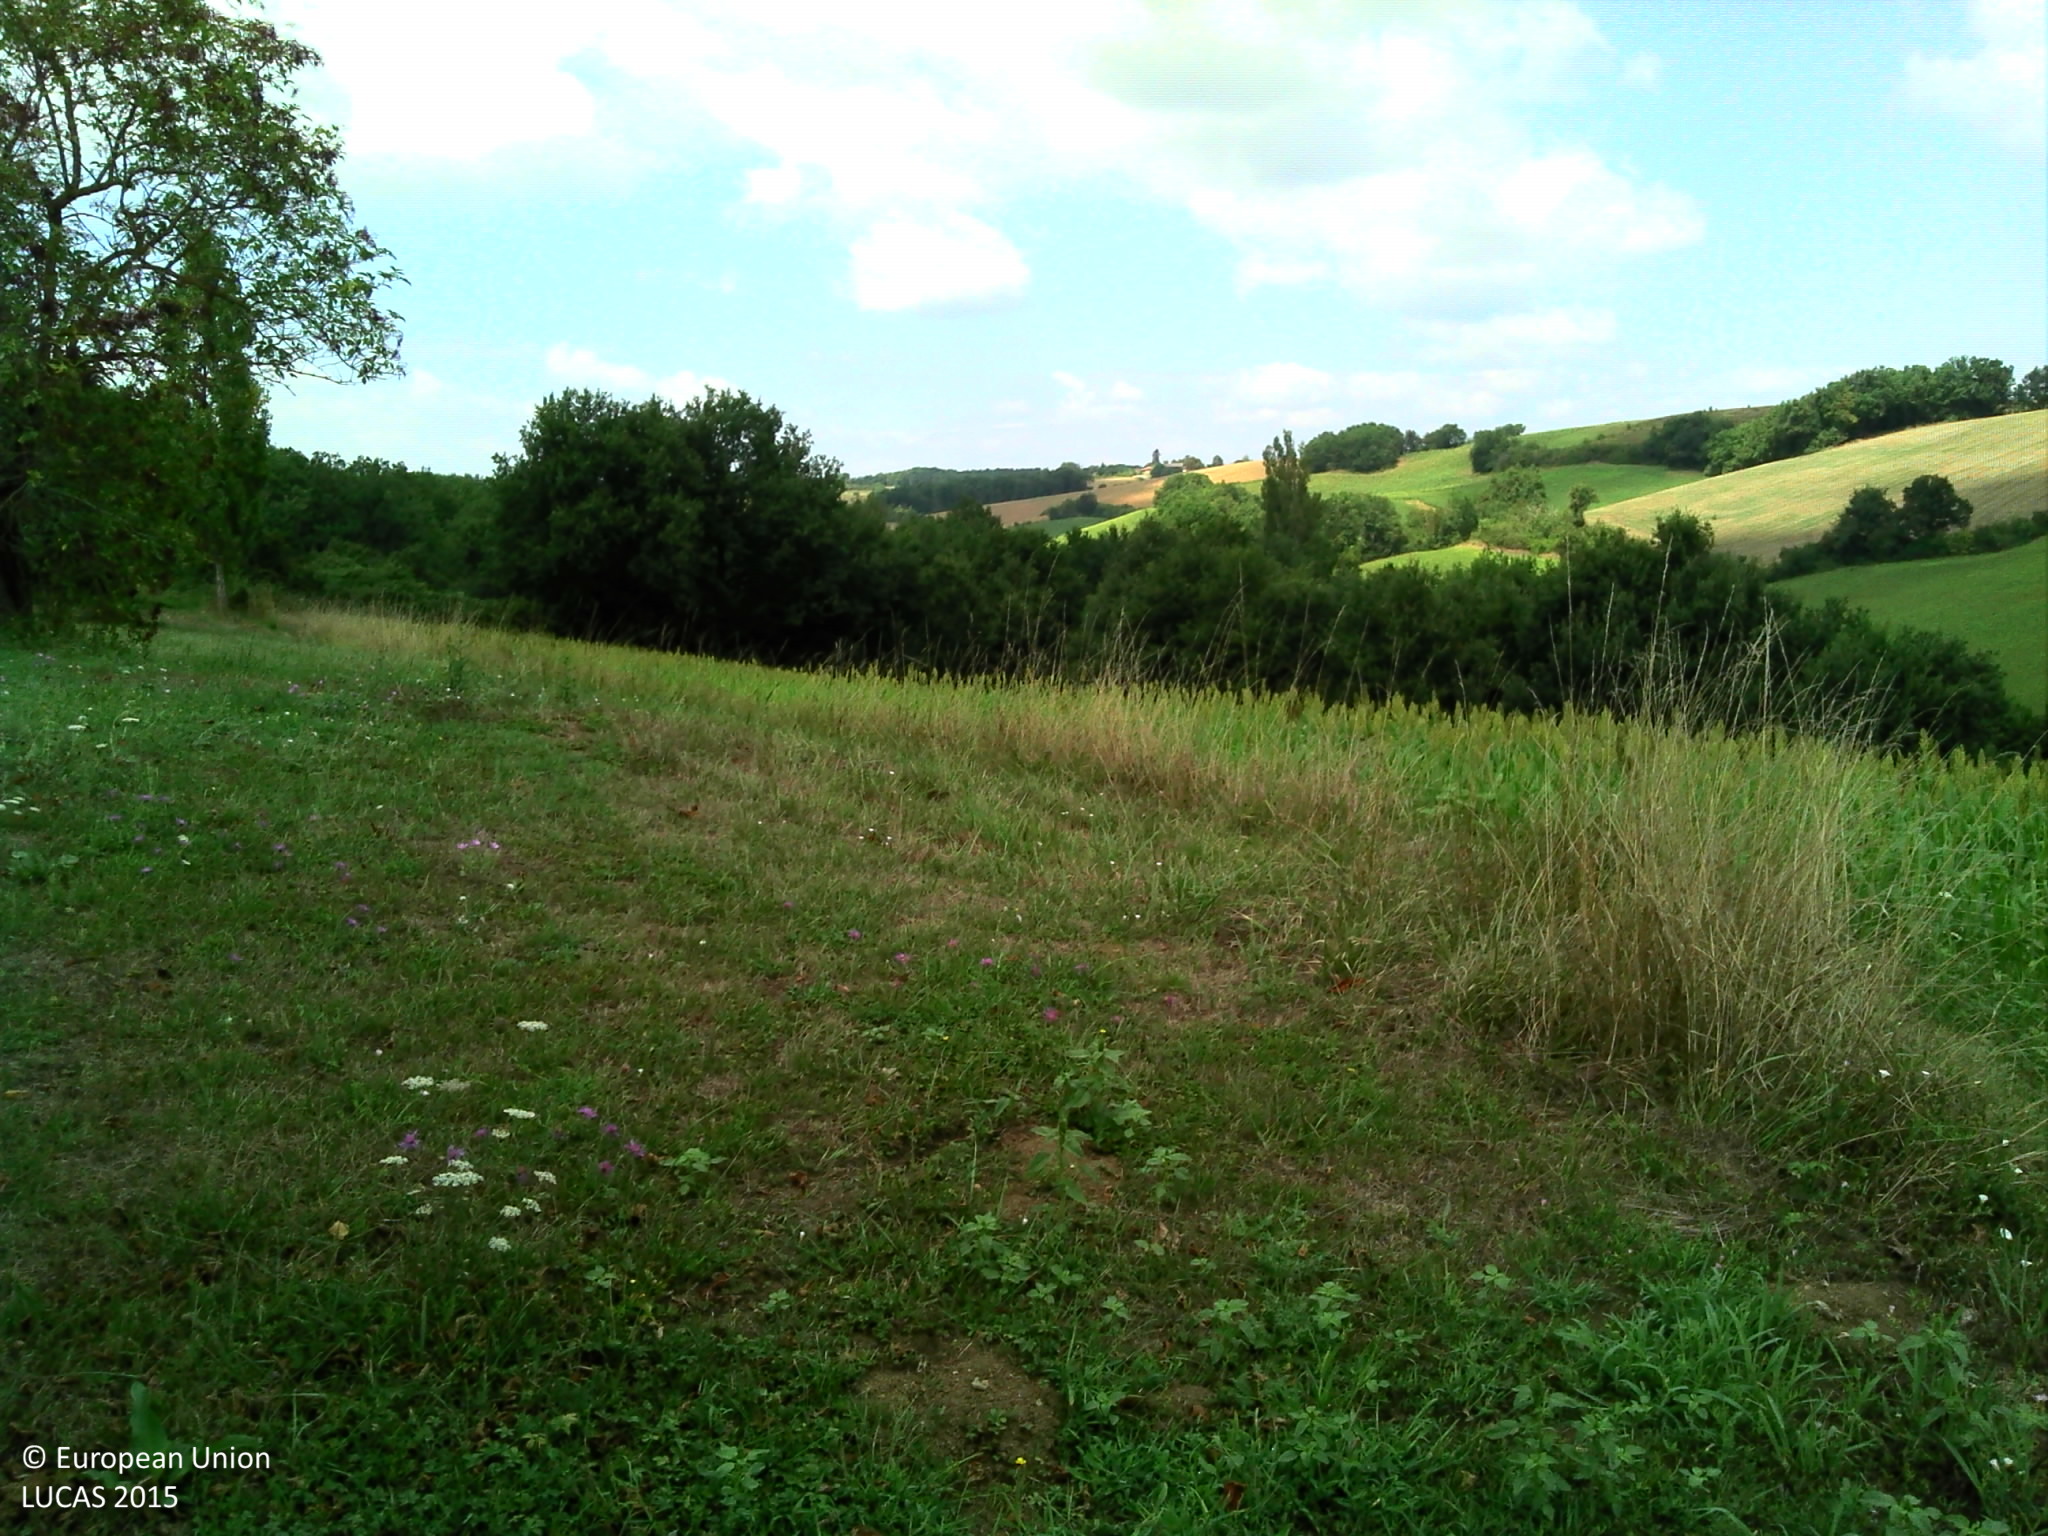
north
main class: Grassland
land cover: Grassland with sparse tree/shrub cover
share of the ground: > 75 %
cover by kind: herbaceous plants 95 %, broadleaved forest trees 5 %
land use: Residential
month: August
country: FR
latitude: 43.9682
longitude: 1.5379
